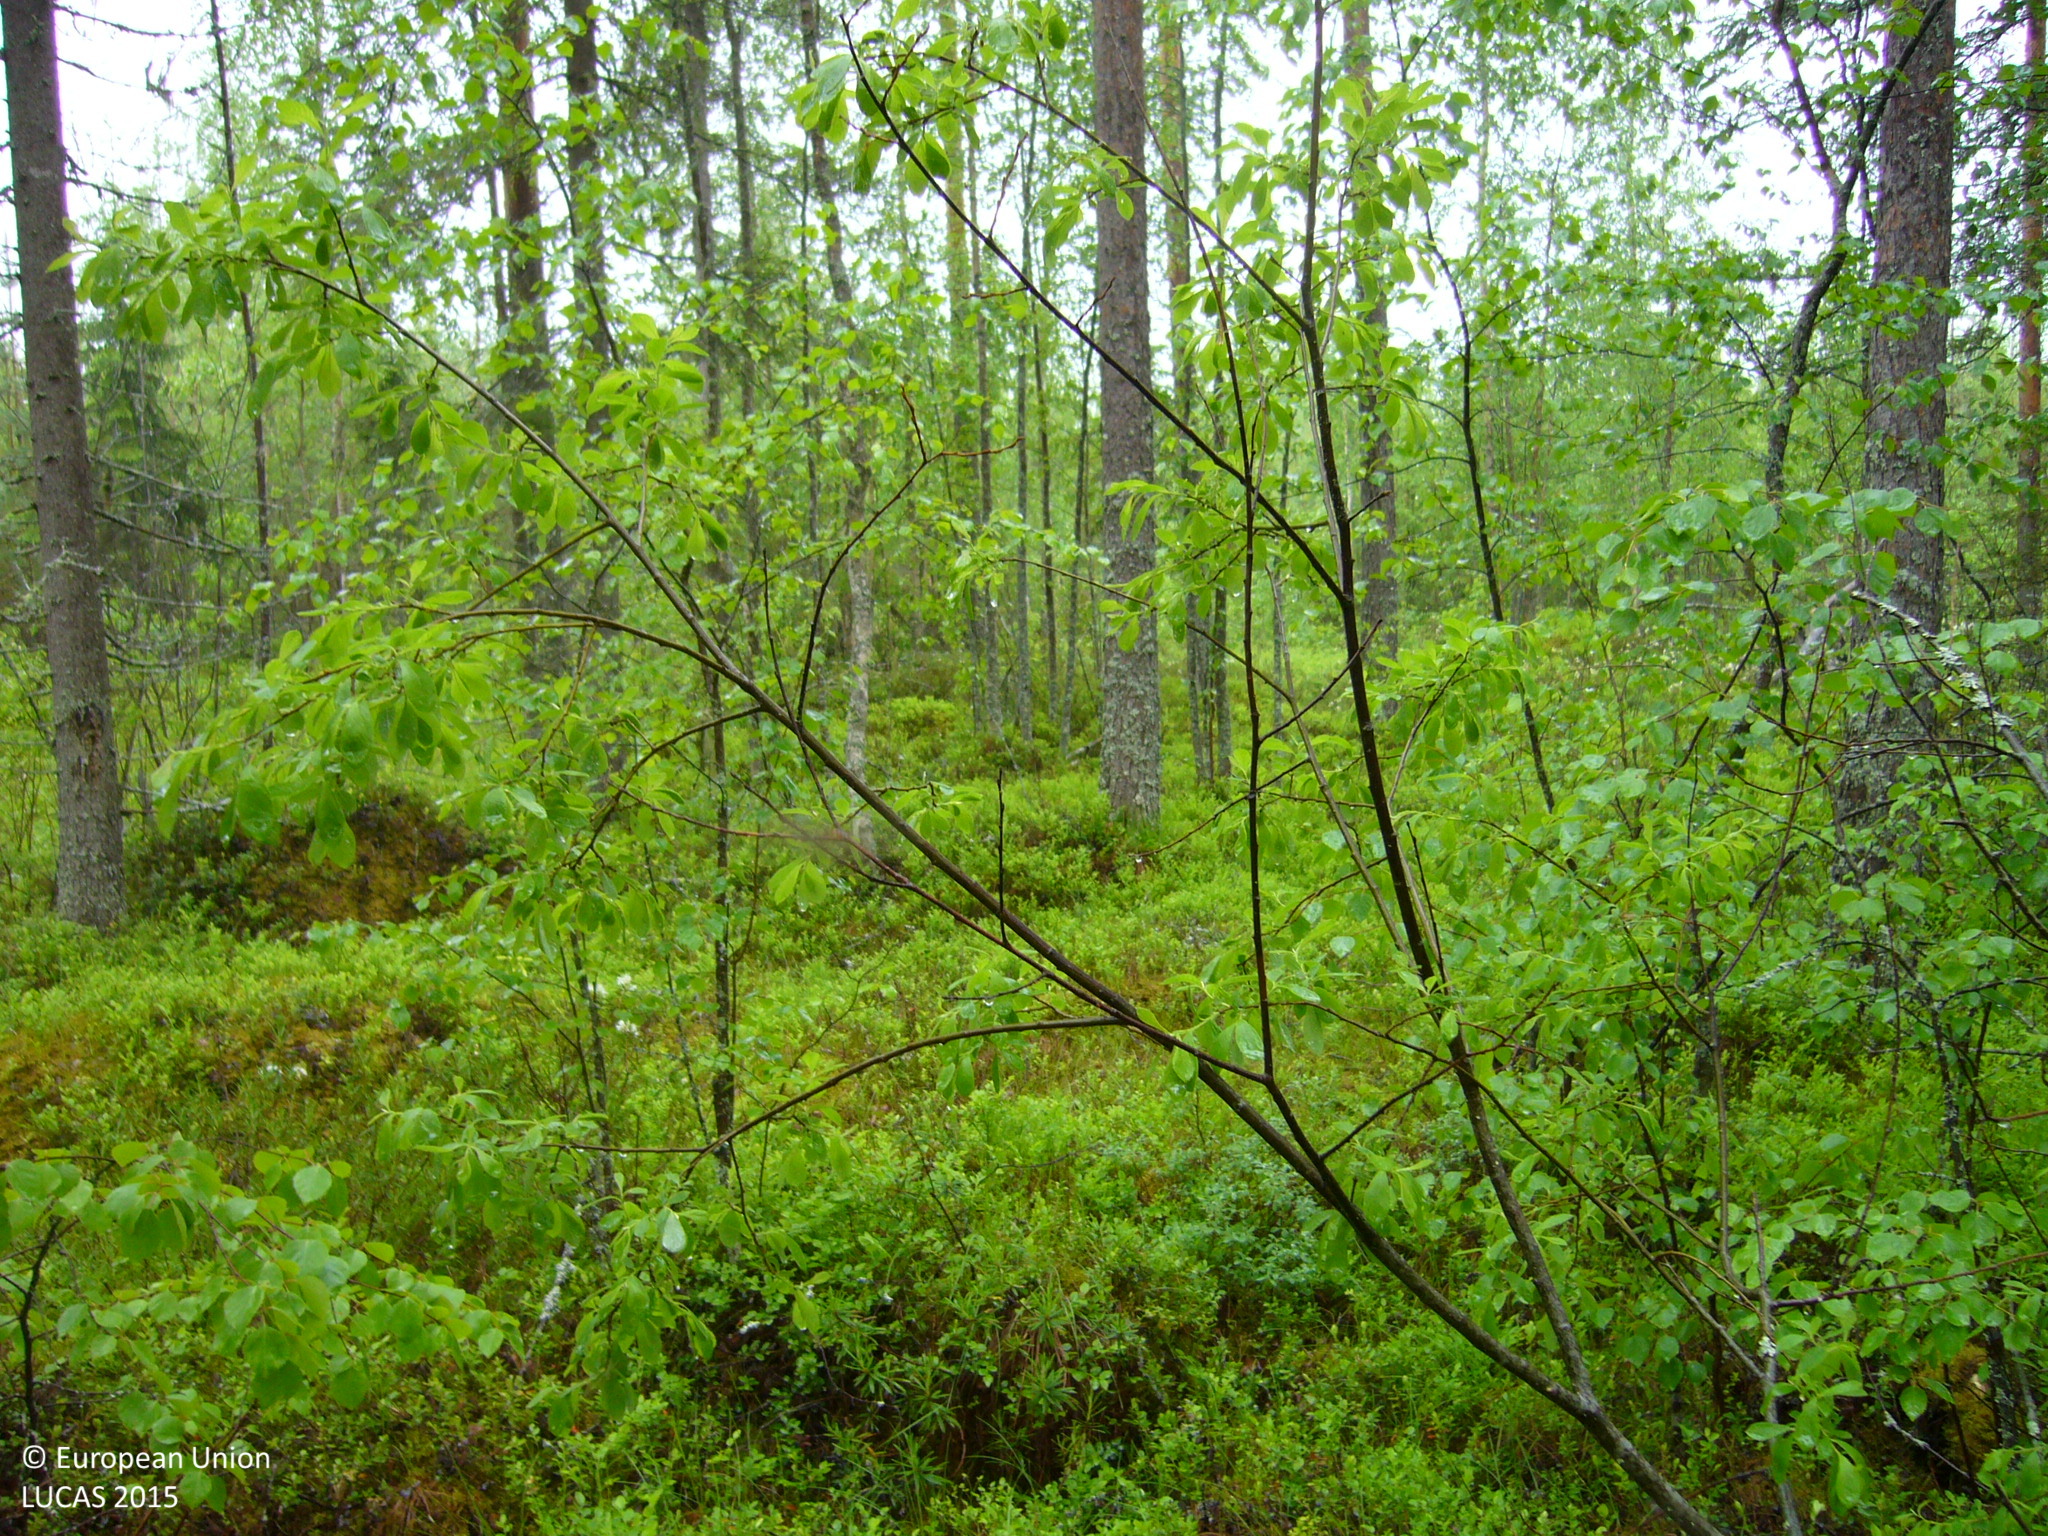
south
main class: Woodland
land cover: Pine dominated mixed woodland
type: boreal forest
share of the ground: 50 - 75 %
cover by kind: coniferous forest trees 40 %, shrubs 35 %, broadleaved forest trees 25 %
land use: Forestry
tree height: > 5 m
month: June
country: FI
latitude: 63.8036
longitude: 25.0517
